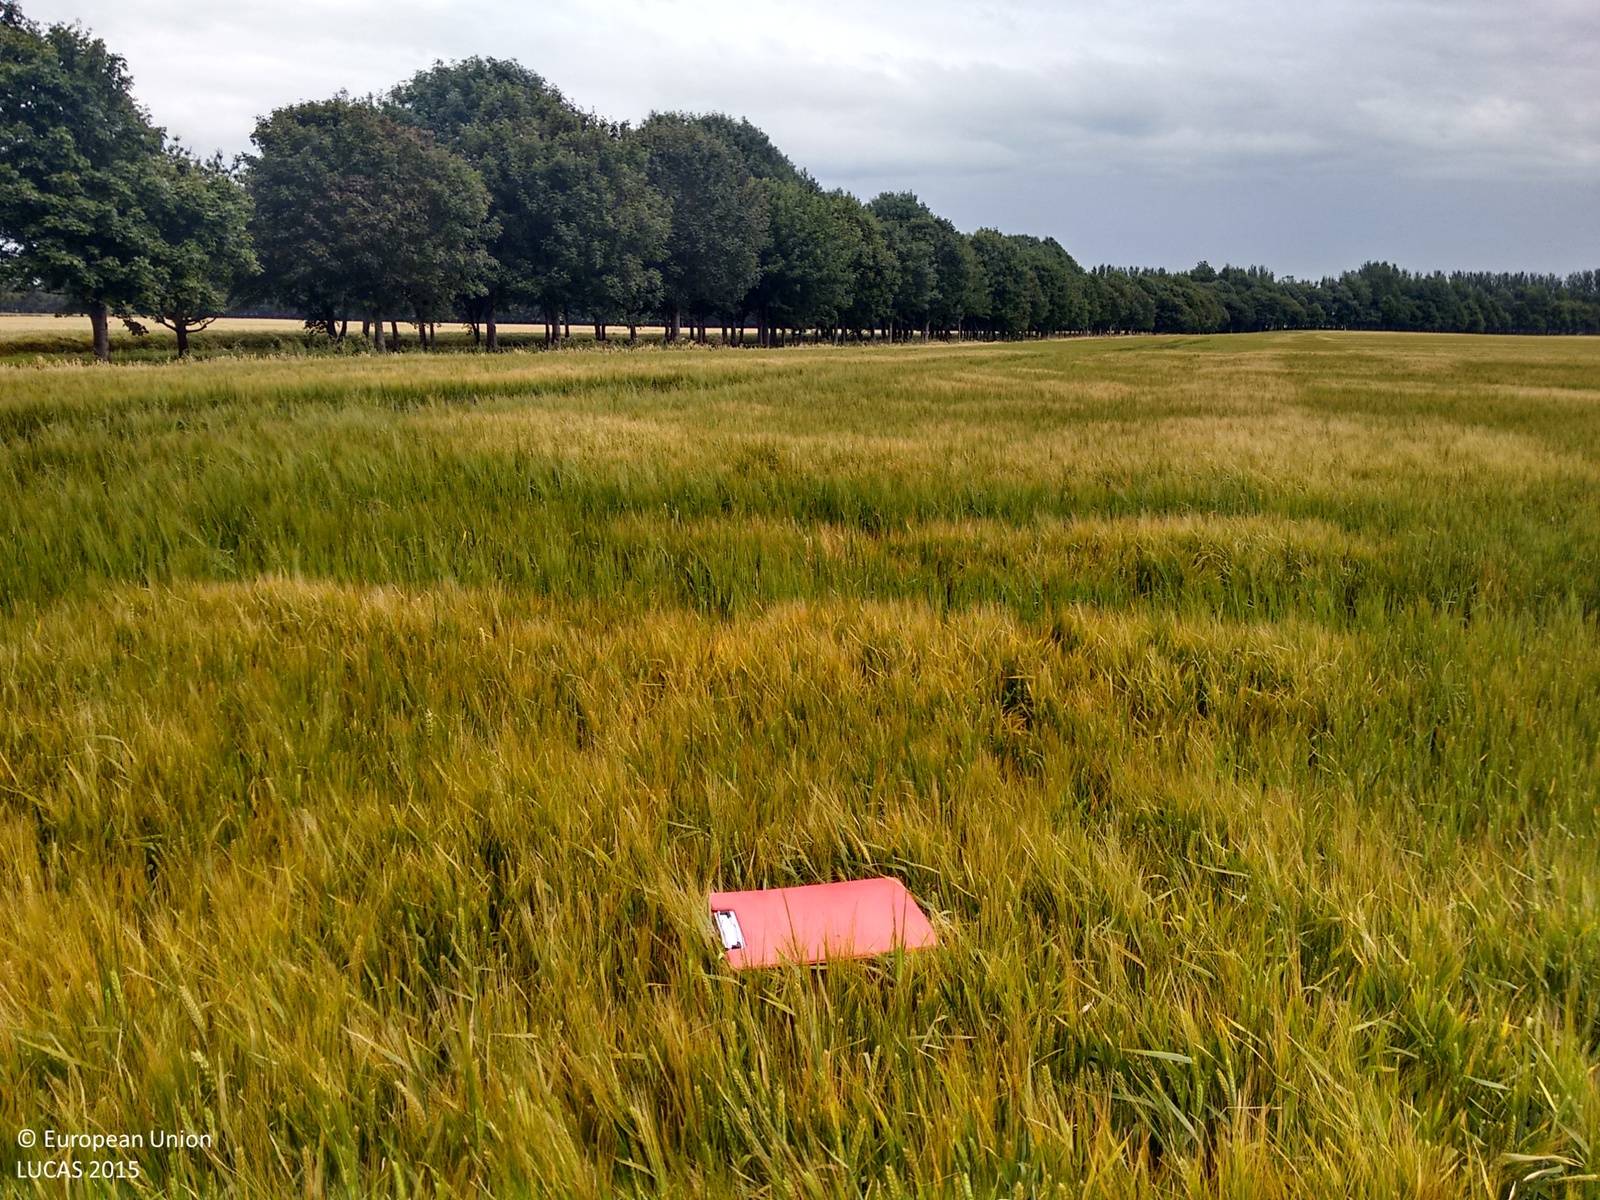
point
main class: Cropland
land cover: Common wheat
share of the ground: > 75 %
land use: Agriculture (excluding fallow land and kitchen gardens)
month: August
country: IE
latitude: 53.8831
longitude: -6.4479
